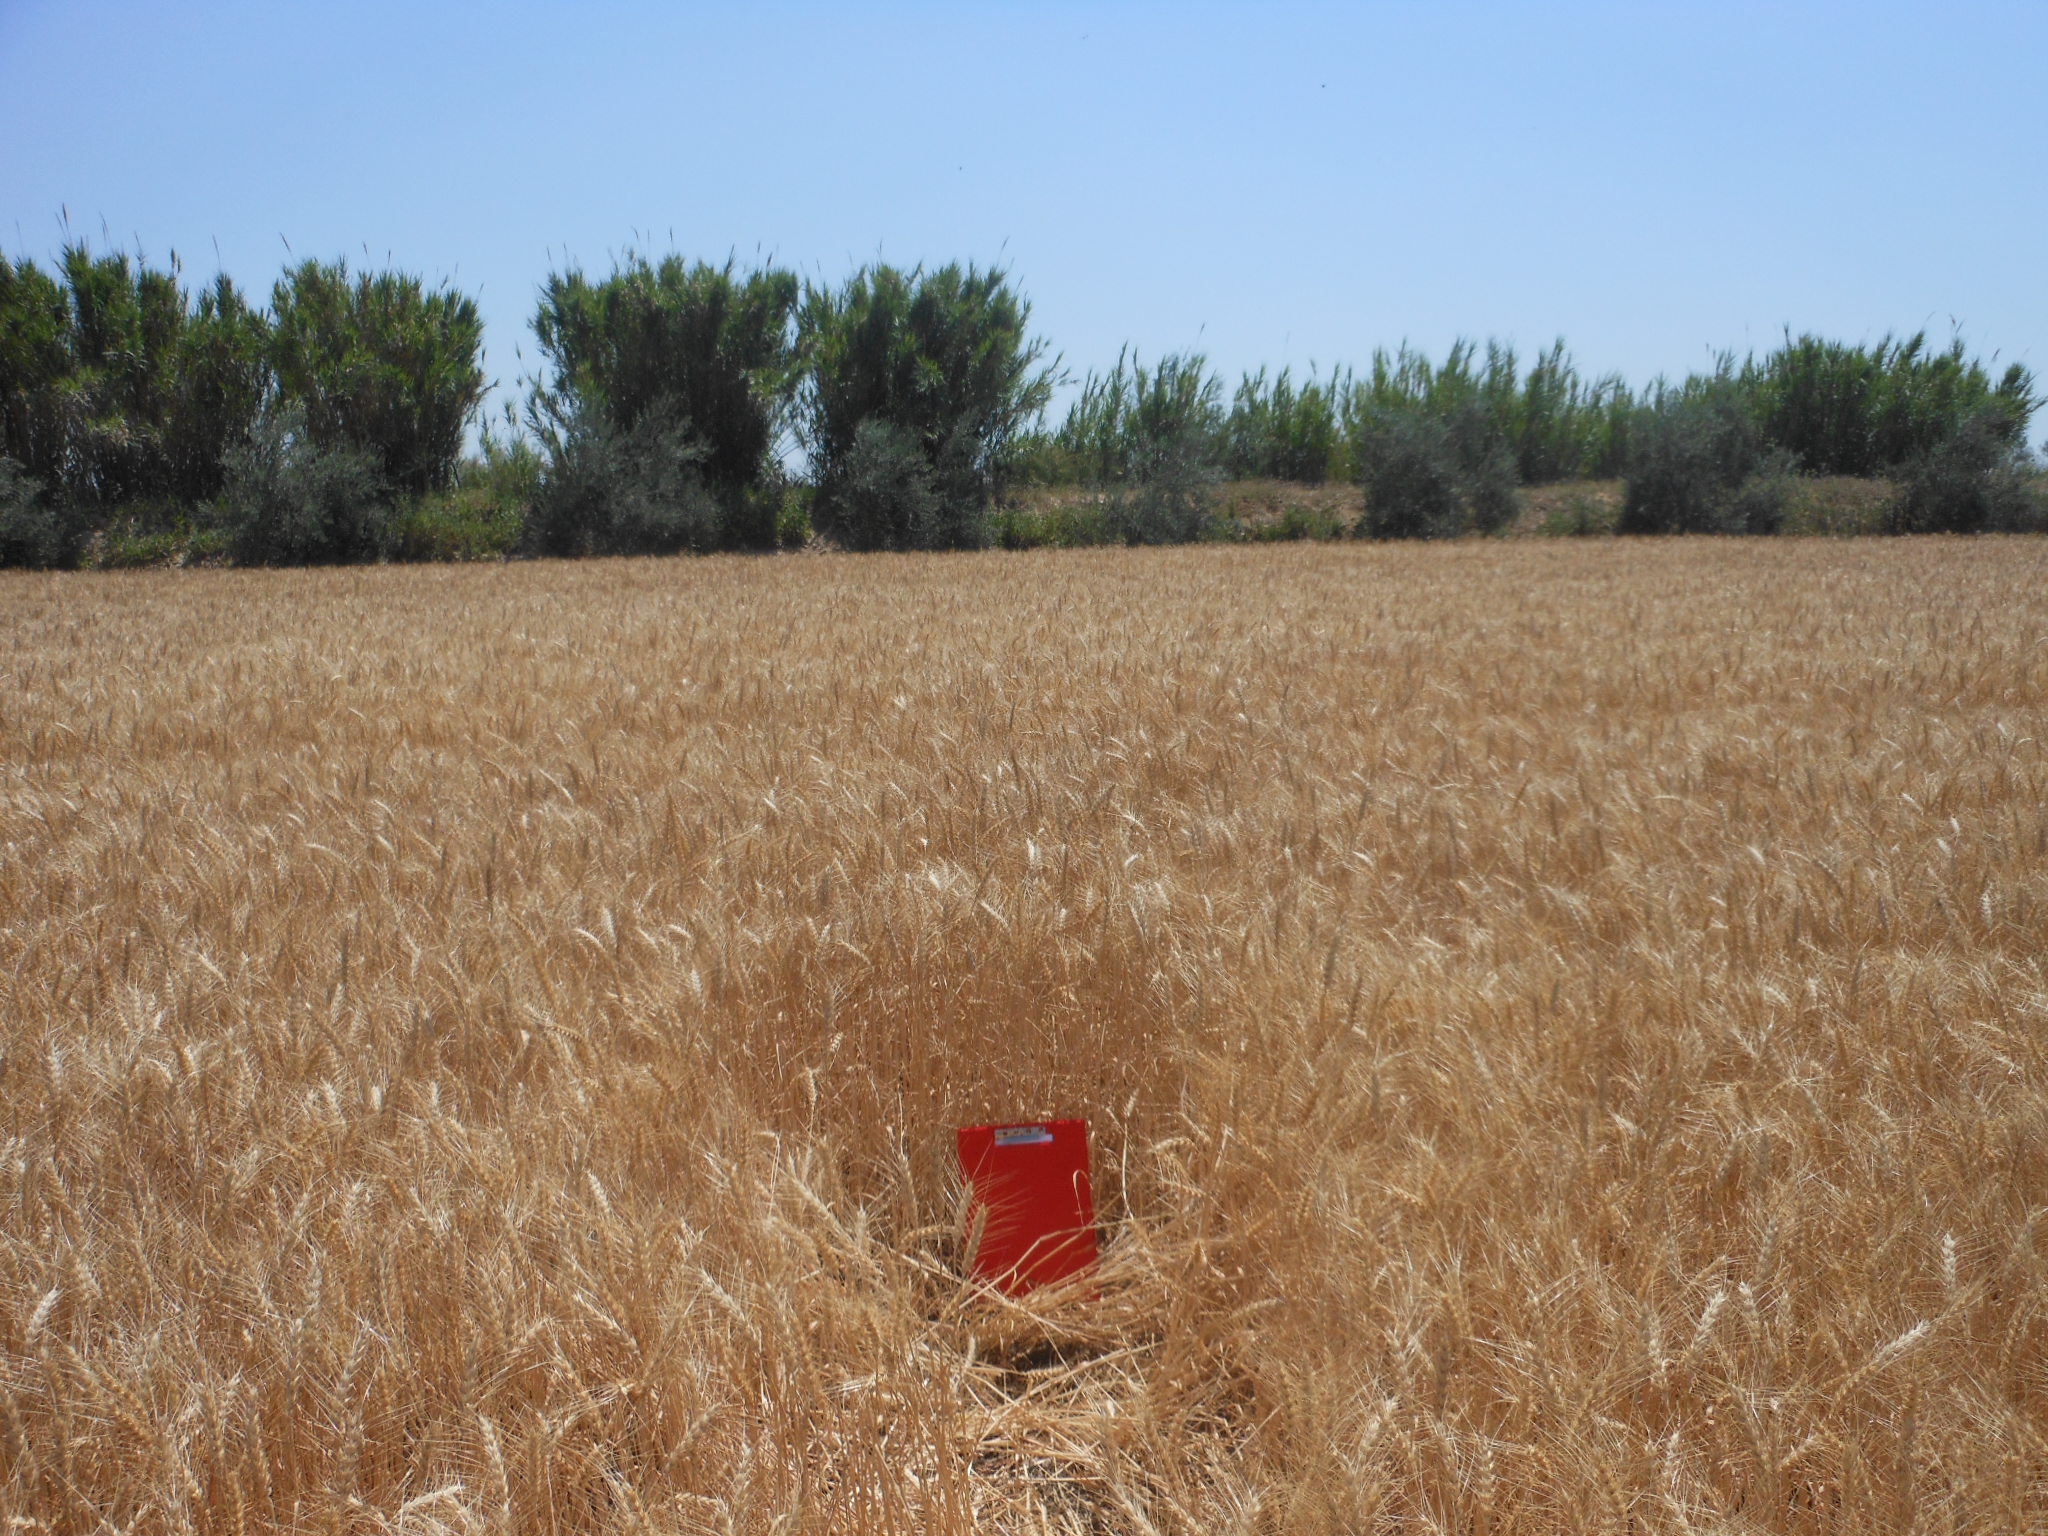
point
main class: Cropland
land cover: Common wheat
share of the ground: > 75 %
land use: Agriculture (excluding fallow land and kitchen gardens)
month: May
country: ES
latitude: 37.4961
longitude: -5.4108
